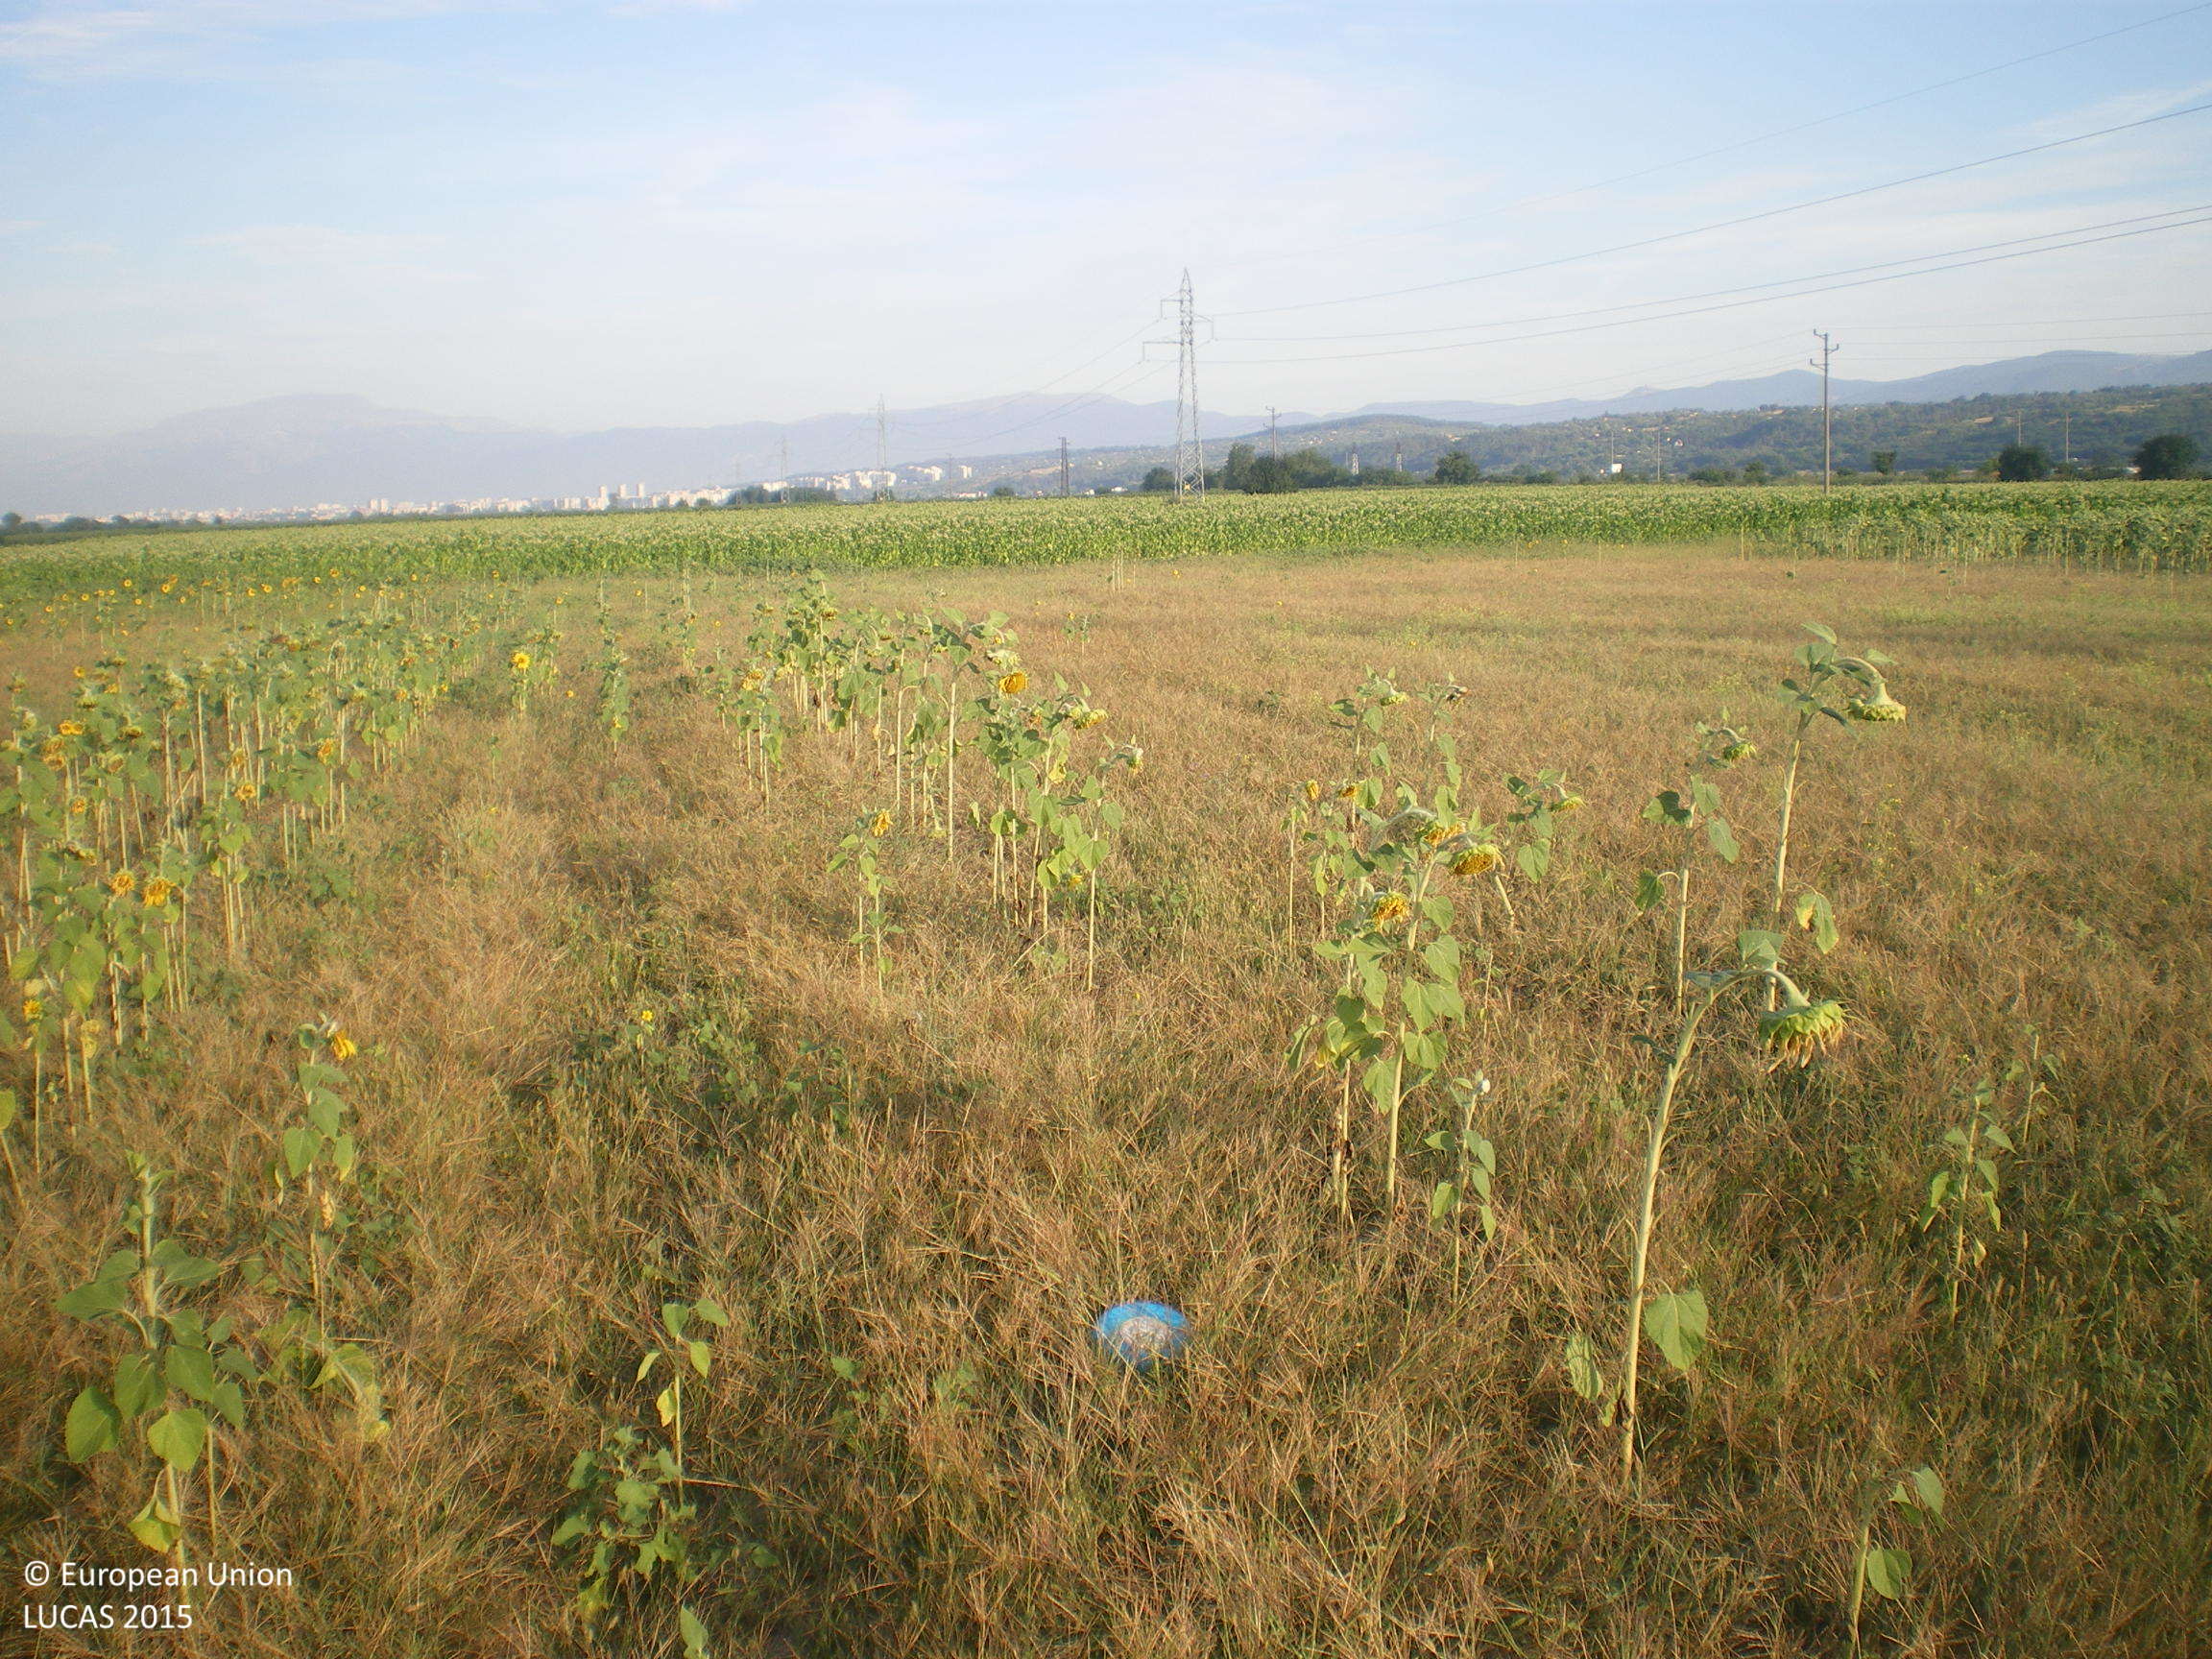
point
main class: Cropland
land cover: Sunflower
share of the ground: < 10 %
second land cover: Spontaneously vegetated surfaces
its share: > 75 %
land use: Agriculture (excluding fallow land and kitchen gardens)
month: August
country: BG
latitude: 42.5961
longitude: 25.4629
